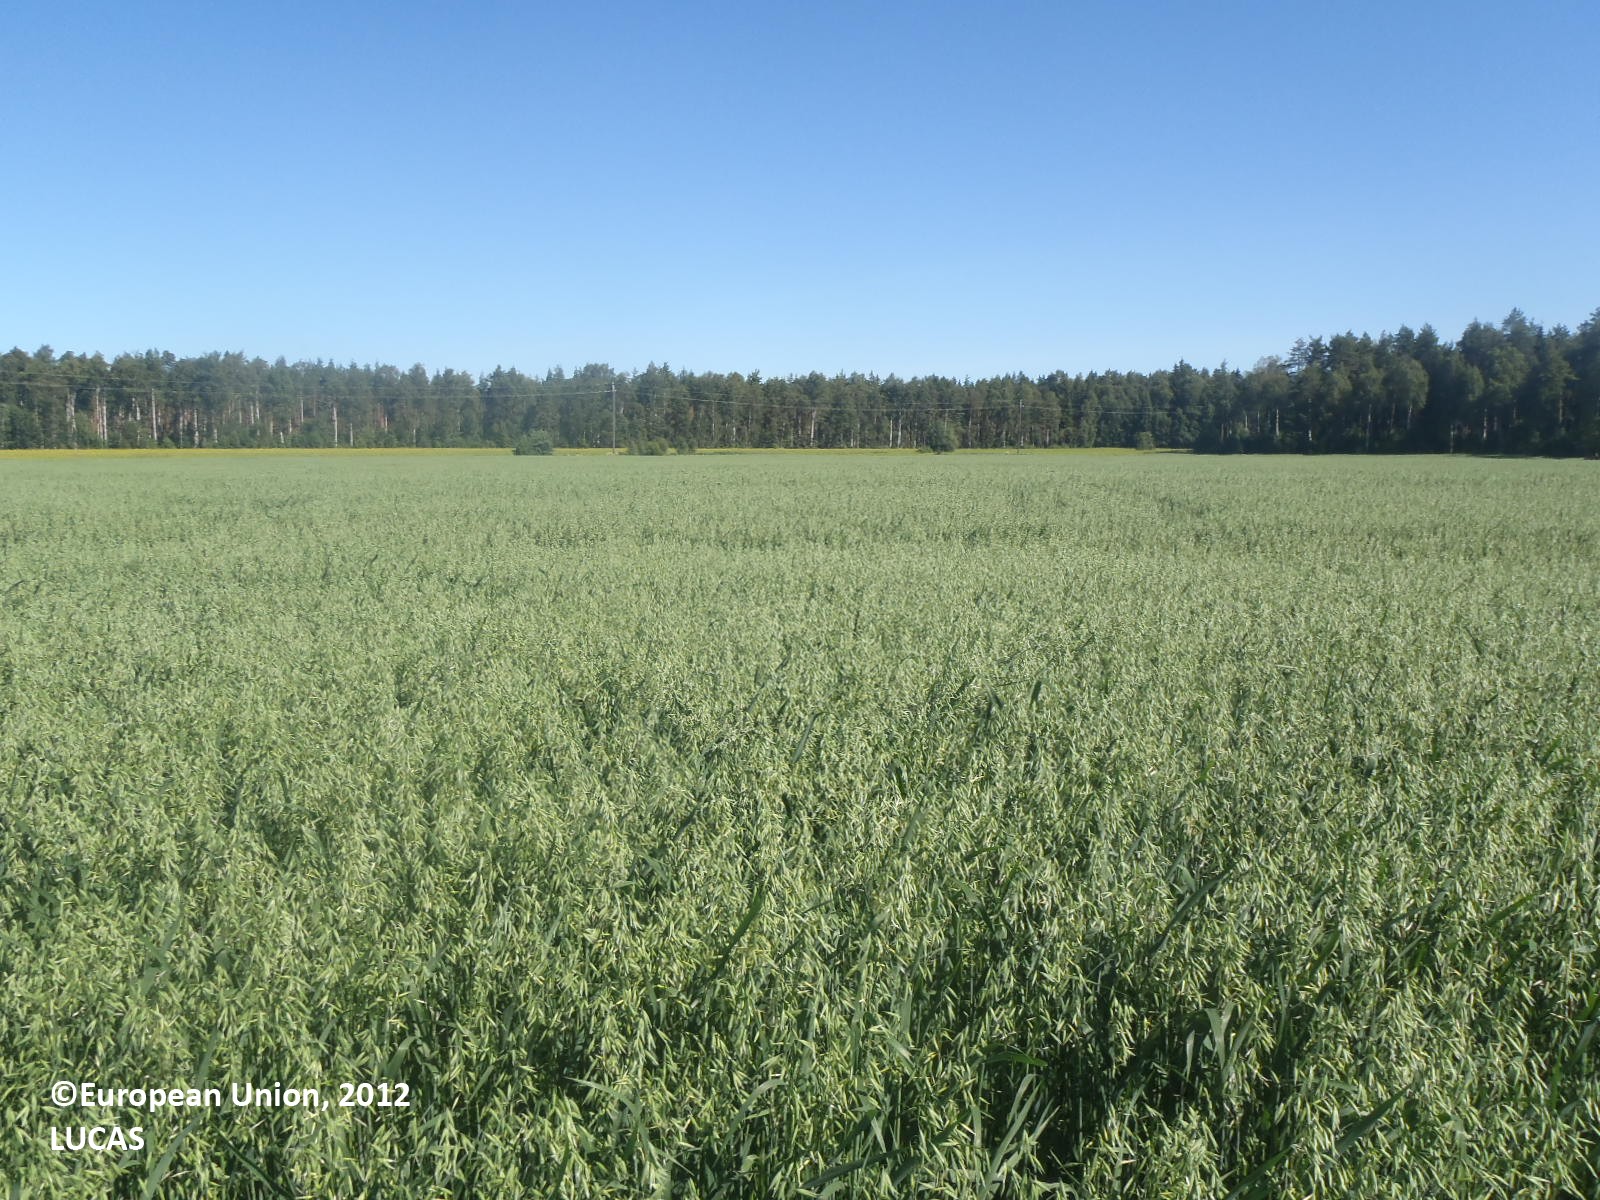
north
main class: Cropland
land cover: Oats
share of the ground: > 75 %
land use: Agriculture (excluding fallow land and kitchen gardens)
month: July
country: FI
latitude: 61.0438
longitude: 21.8902
